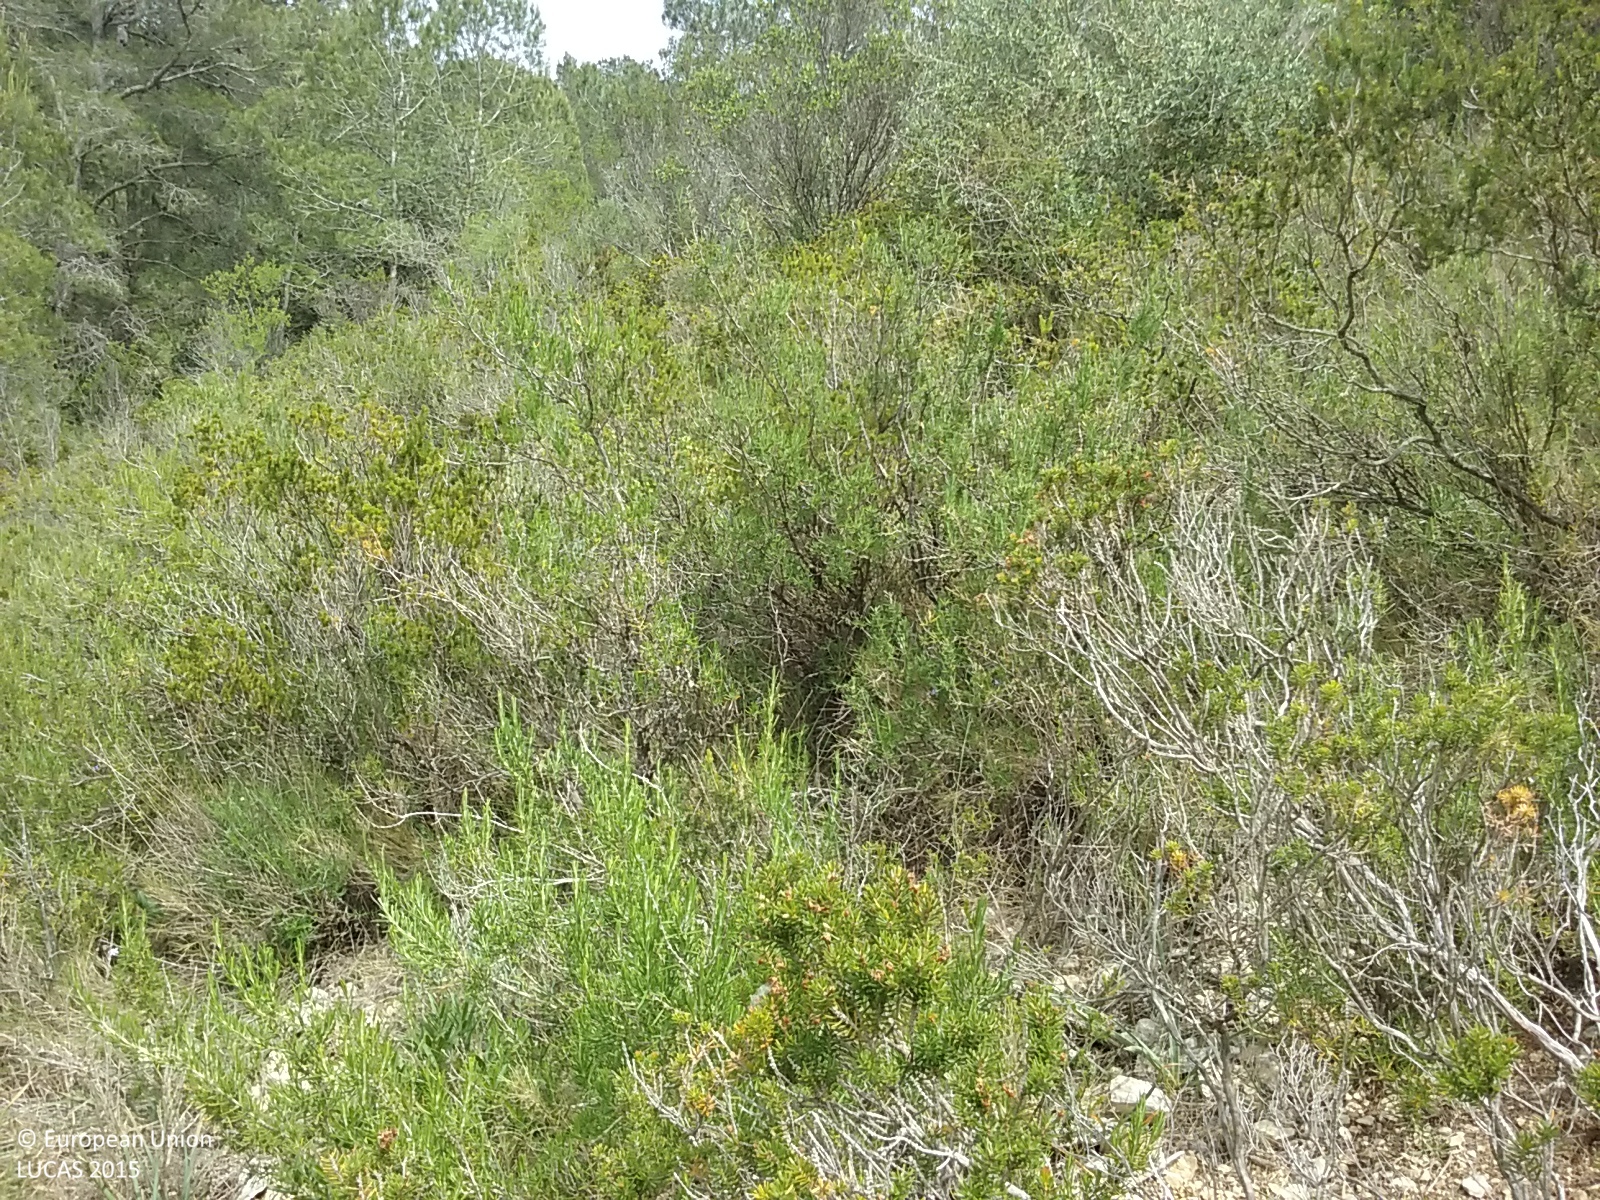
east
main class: Woodland
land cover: Pine dominated coniferous woodland
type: coniferous forest of the mediterranean region
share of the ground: 10 - 25 %
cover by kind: shrubs 80 %, coniferous forest trees 15 %, herbaceous plants 5 %
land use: Semi-natural and natural areas not in use
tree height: > 5 m
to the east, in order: Pine dominated coniferous woodland; Tracks; Pine dominated coniferous woodland; Tracks; Pine dominated coniferous woodland; Dry stone walls; Pine dominated coniferous woodland; Dry stone walls; Pine dominated coniferous woodland; Dry stone walls; Pine dominated coniferous woodland; Dry stone walls; Pine dominated coniferous woodland; Tracks; Pine dominated coniferous woodland; Tracks; Pine dominated coniferous woodland; Dry stone walls; Pine dominated coniferous woodland; Dry stone walls; Pine dominated coniferous woodland; Dry stone walls; Pine dominated coniferous woodland; Dry stone walls; Pine dominated coniferous woodland; Dry stone walls; Pine dominated coniferous woodland; Olive groves; Fences; Dry stone walls; Olive groves; Dry stone walls
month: May
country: ES
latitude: 40.8131
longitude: 0.5692
